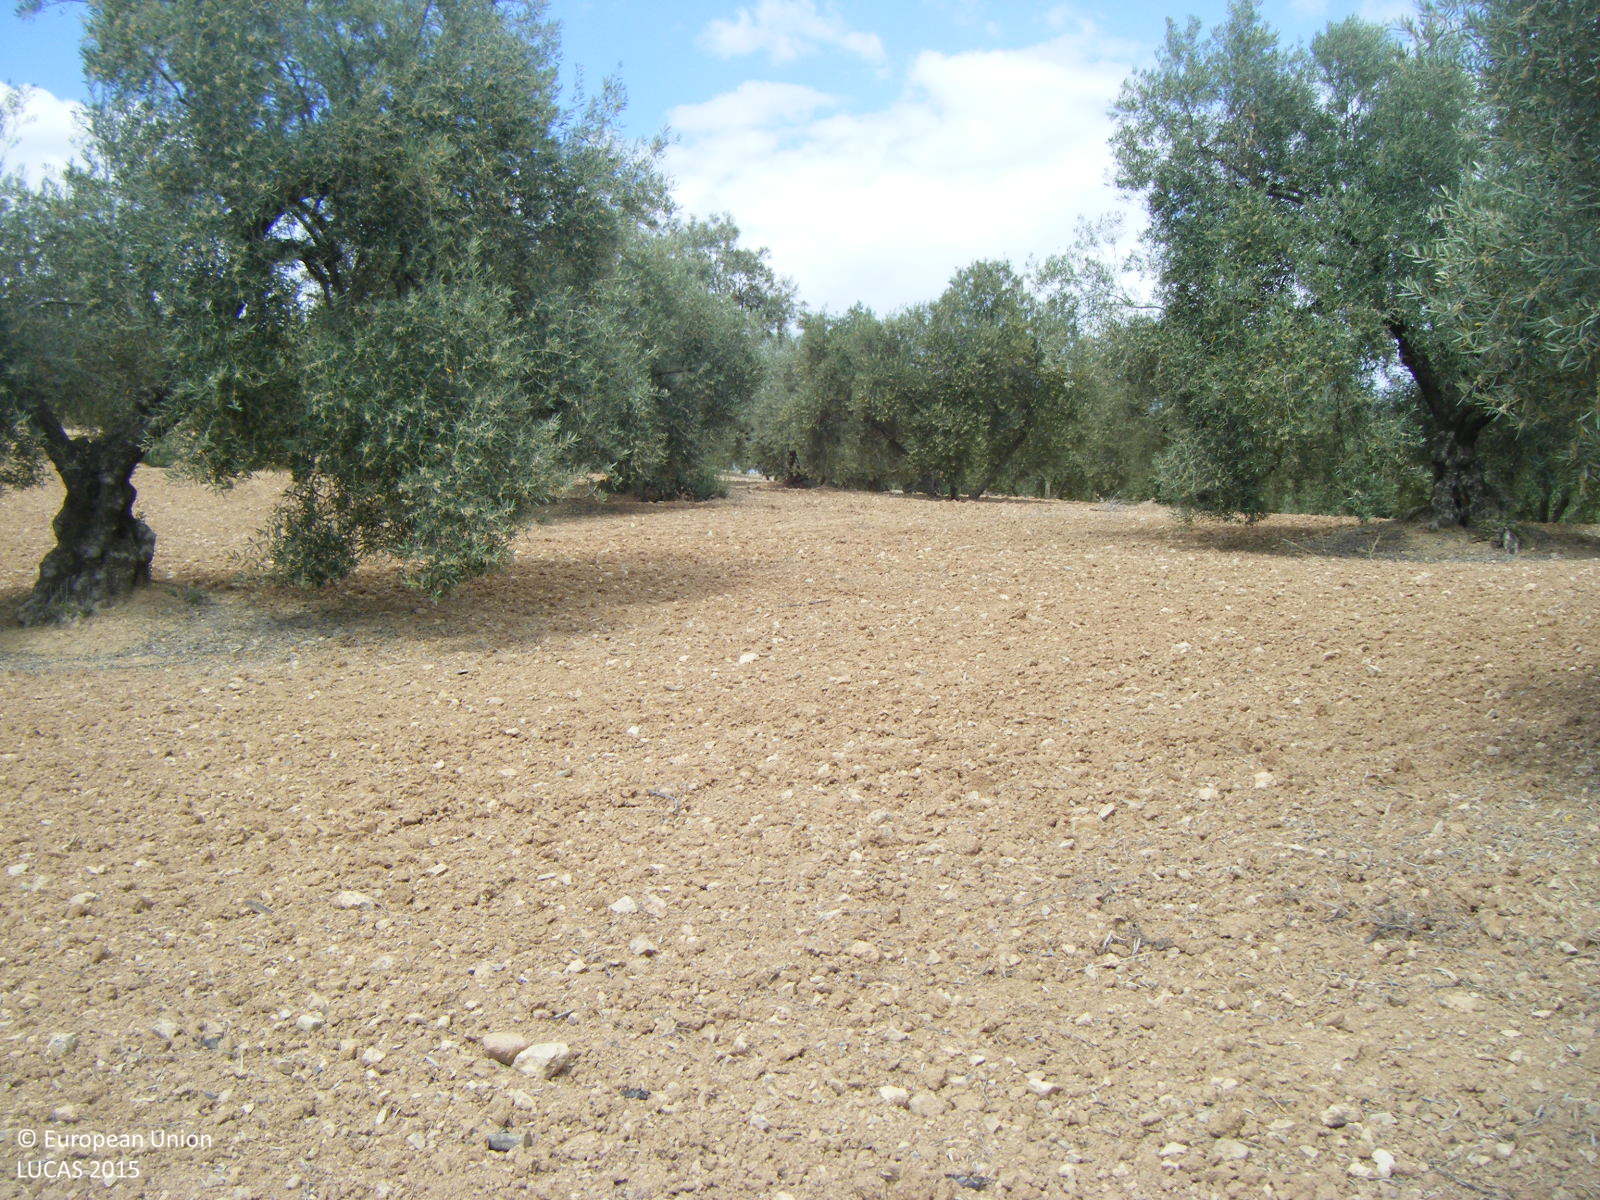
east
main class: Cropland
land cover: Olive groves
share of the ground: 10 - 25 %
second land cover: Other bare soil
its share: > 75 %
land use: Agriculture (excluding fallow land and kitchen gardens)
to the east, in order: Olive groves; Other bare soil; Shrubland without tree cover; Olive groves
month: May
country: ES
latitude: 37.2068
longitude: -4.4551
